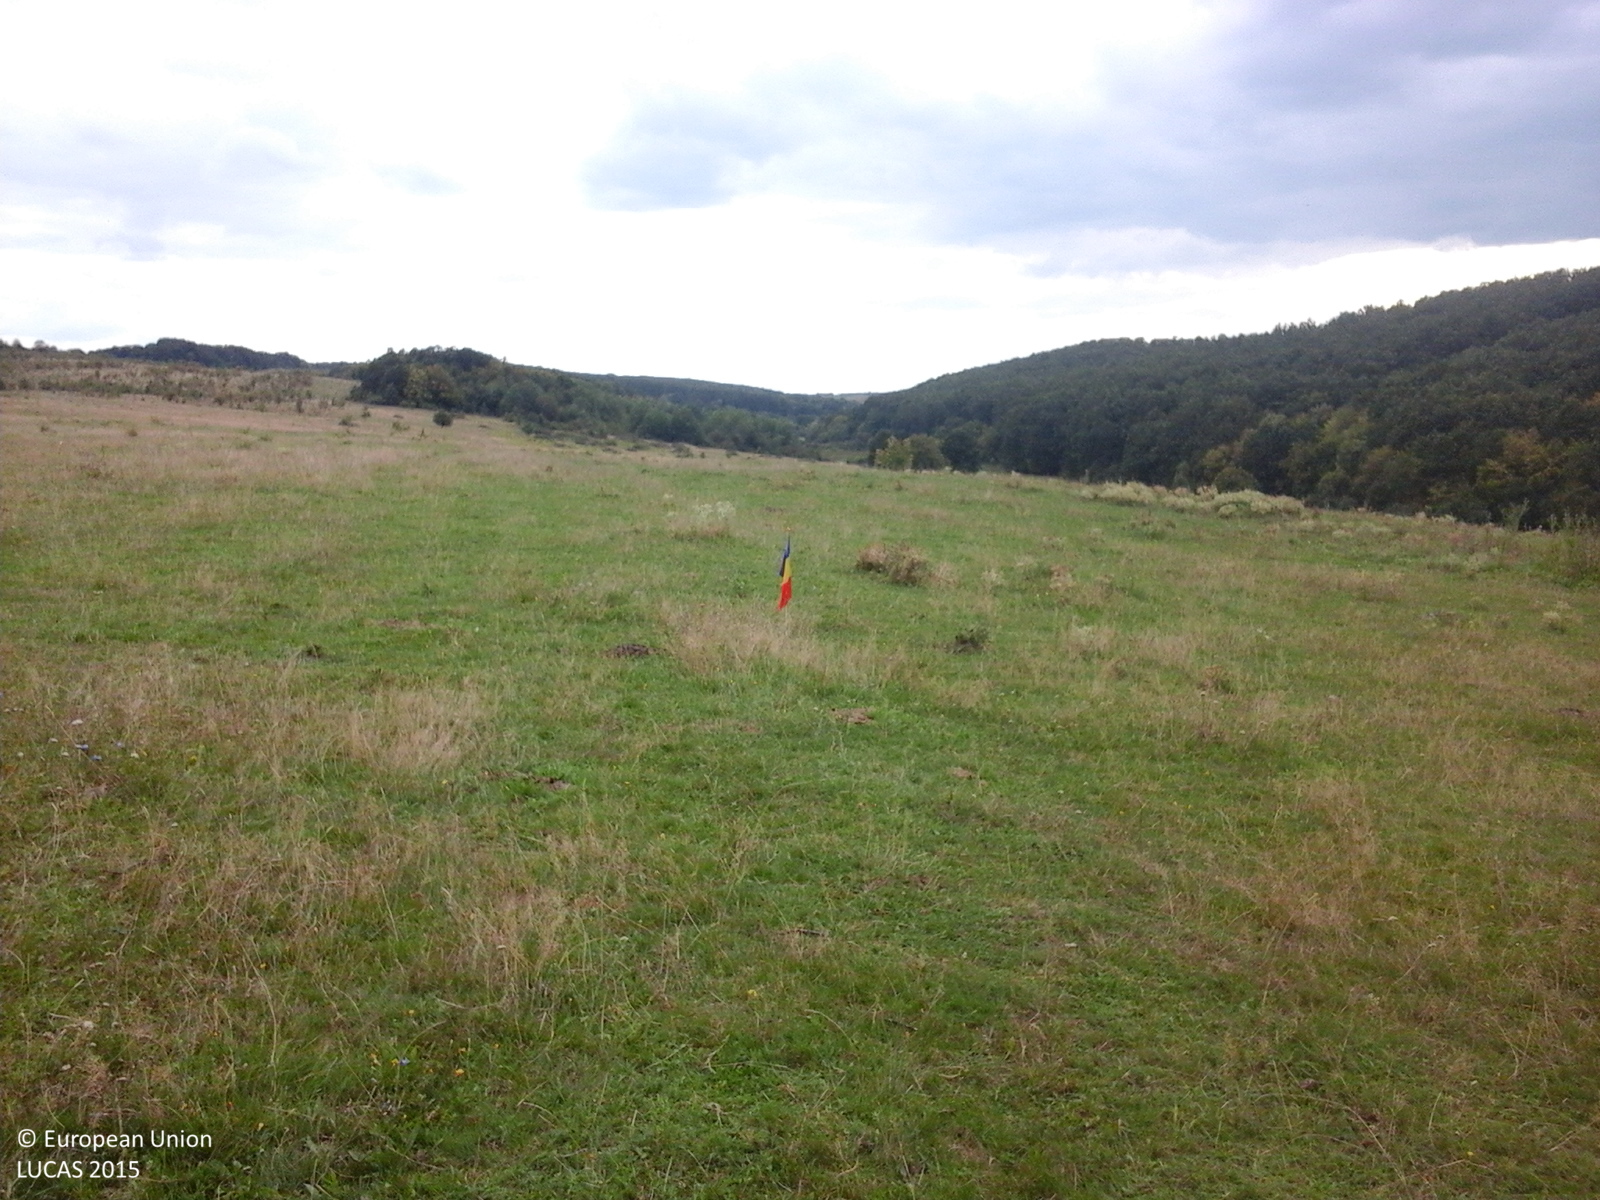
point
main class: Grassland
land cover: Grassland without tree/shrub cover
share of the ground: > 75 %
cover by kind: herbaceous plants 100 %
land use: Agriculture (excluding fallow land and kitchen gardens)
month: September
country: RO
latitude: 47.4345
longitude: 22.6684
